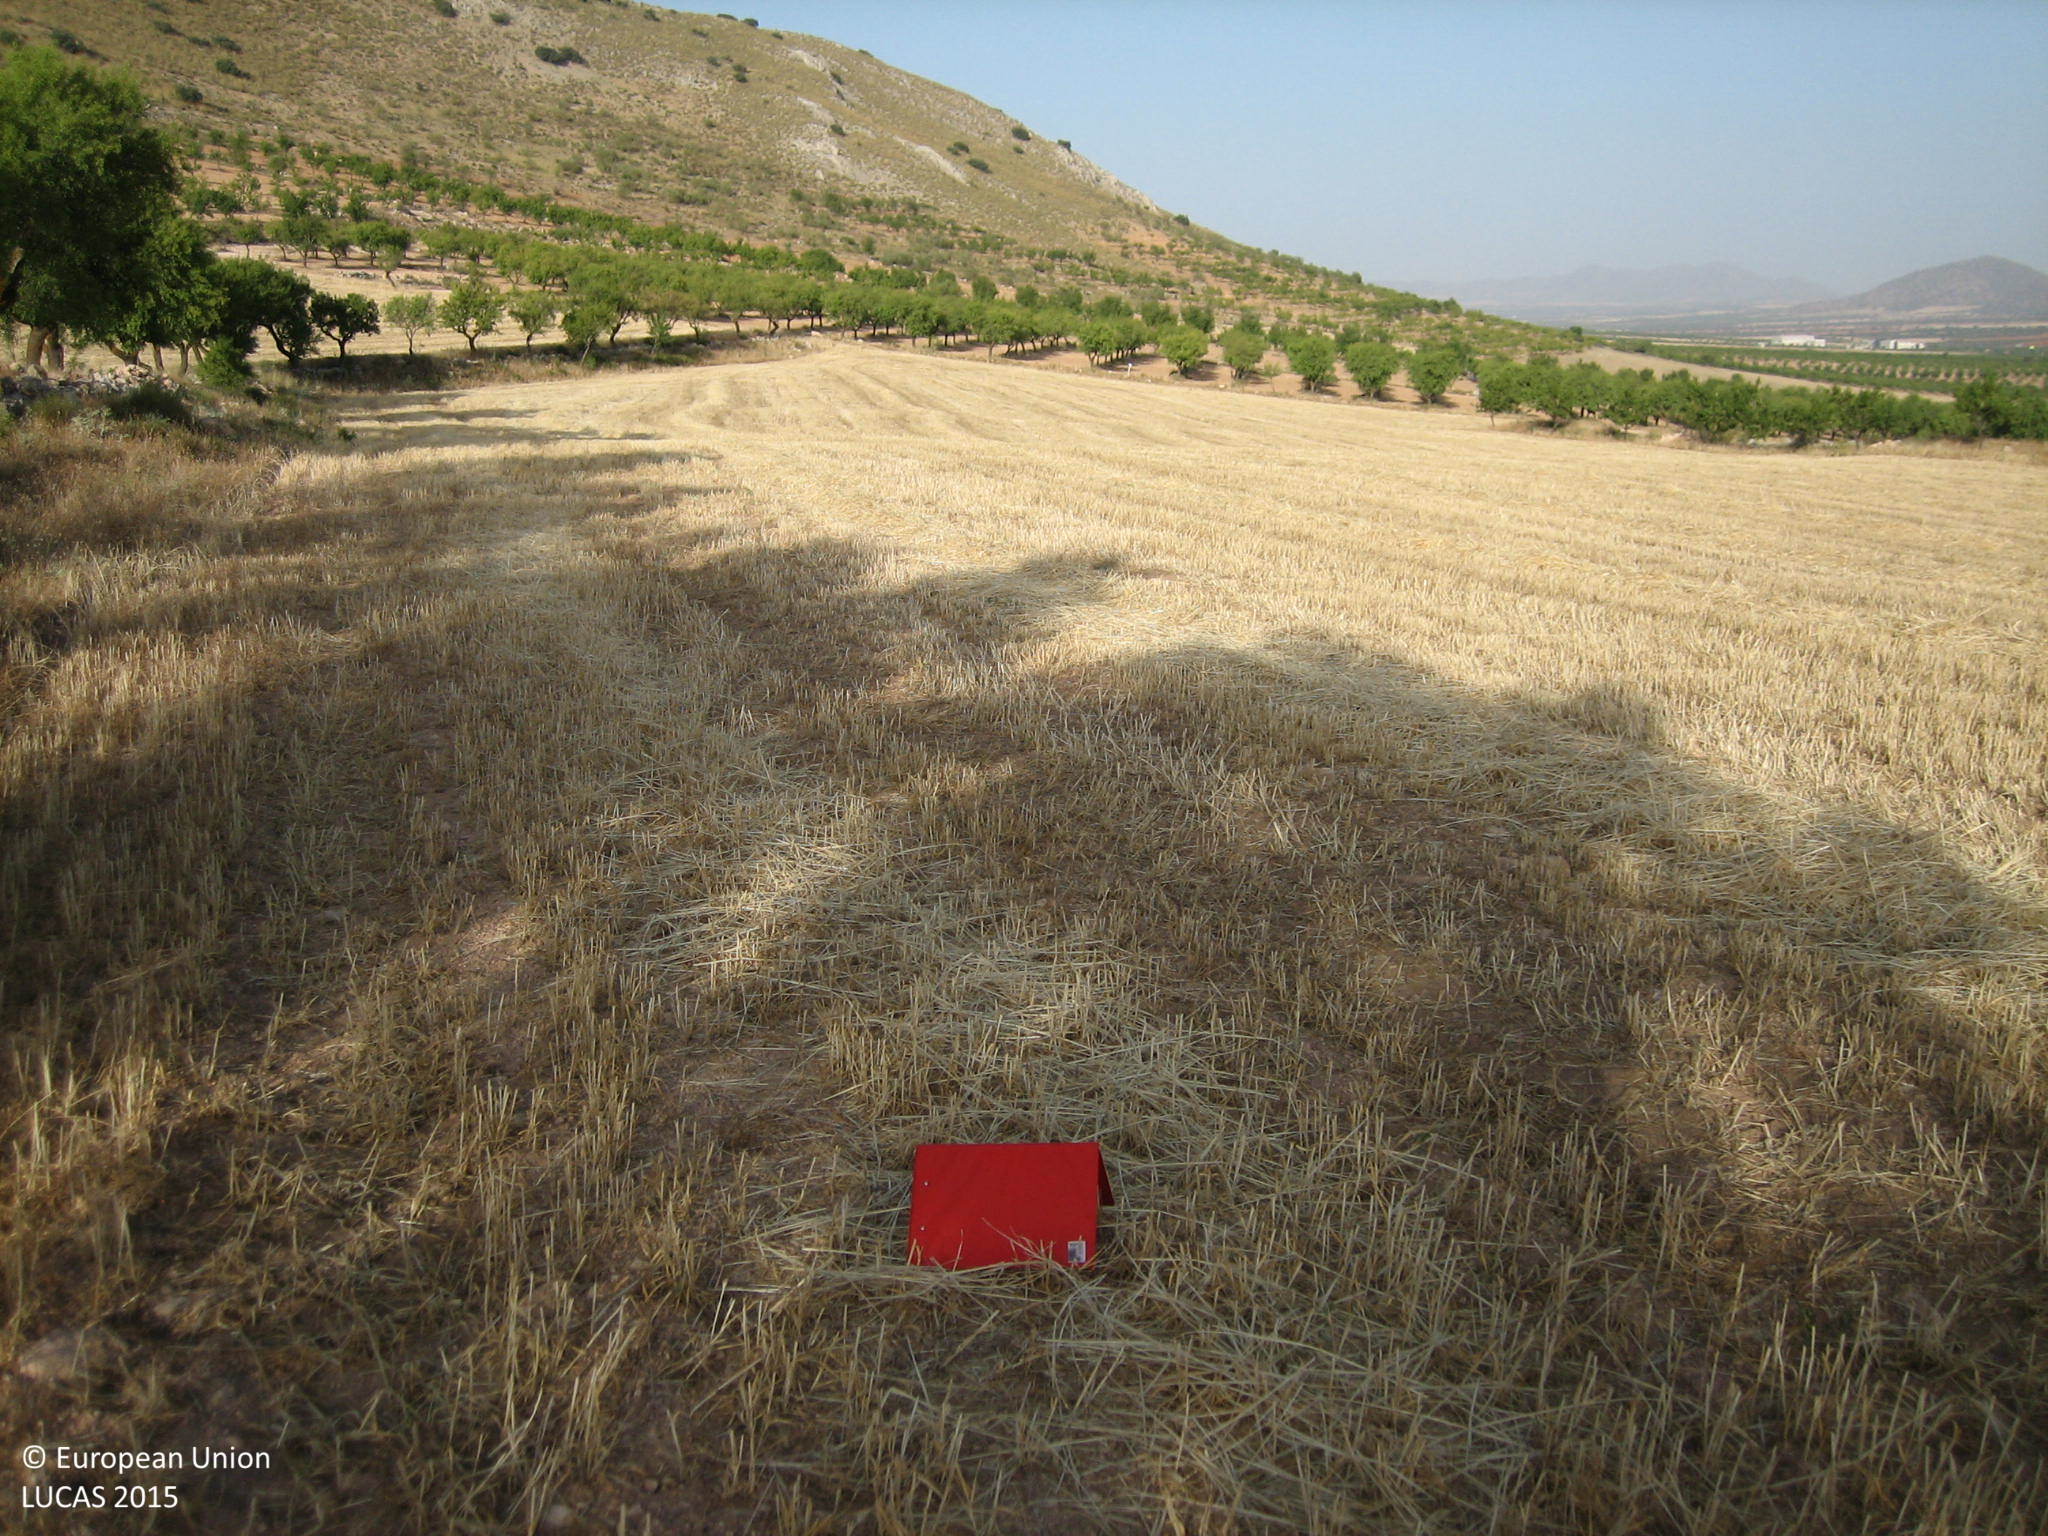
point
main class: Cropland
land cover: Barley
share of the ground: < 10 %
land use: Agriculture (excluding fallow land and kitchen gardens)
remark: Harvested field
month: July
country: ES
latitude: 37.6118
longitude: -2.3907
